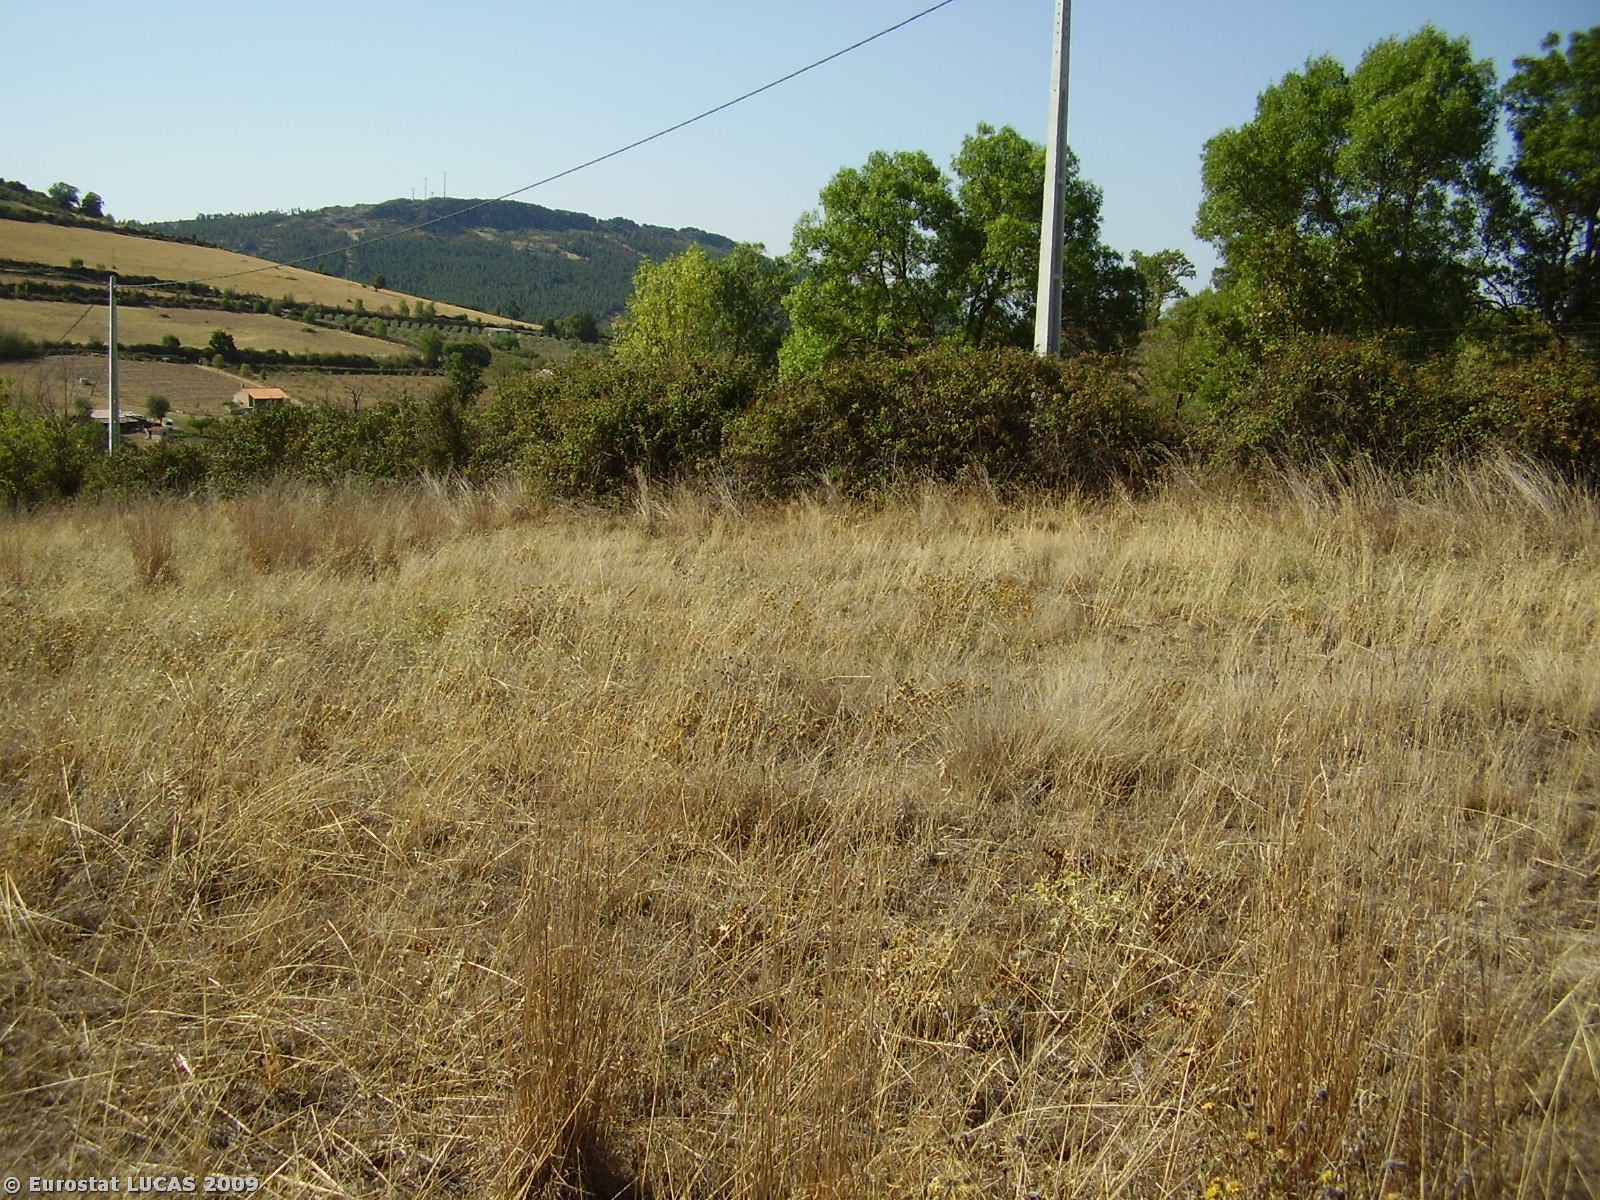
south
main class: Grassland
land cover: Grassland without tree/shrub cover
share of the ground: > 75 %
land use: Fallow land
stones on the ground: > 50 %
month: August
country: PT
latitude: 41.3431
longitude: -6.7291
